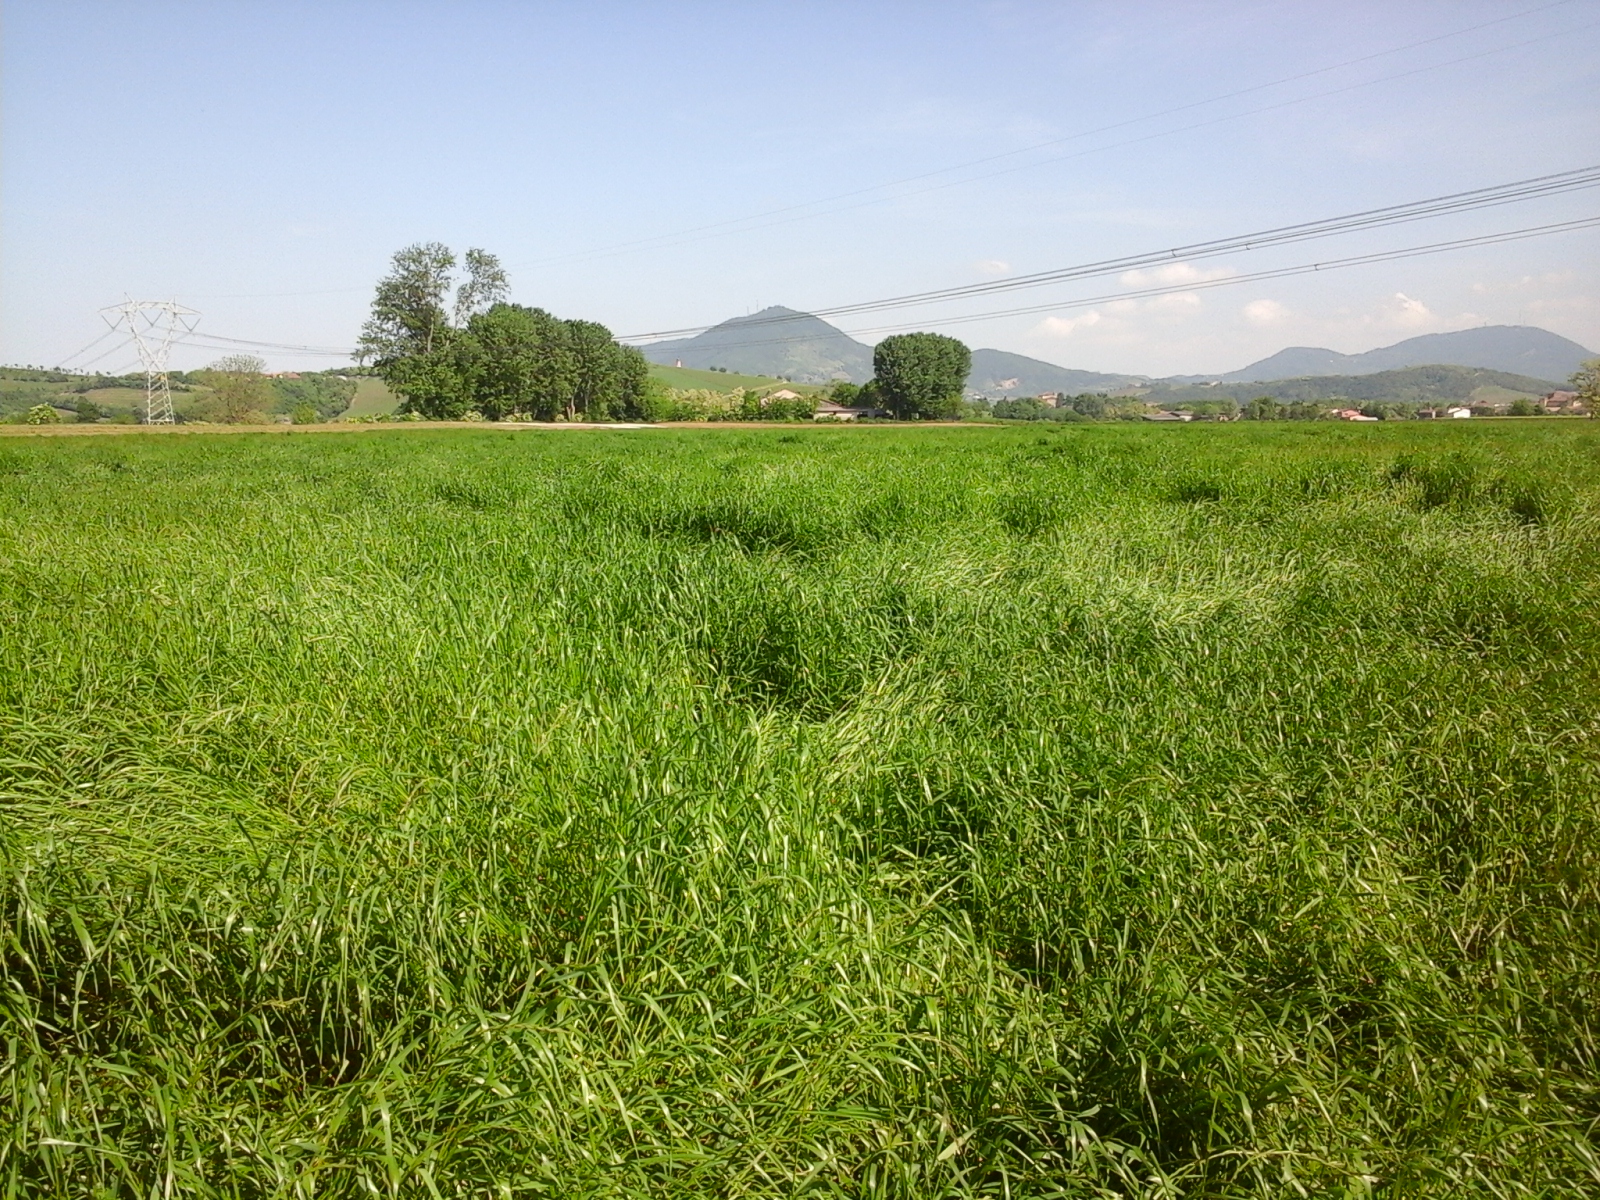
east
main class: Cropland
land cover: Temporary grasslands
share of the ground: > 75 %
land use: Agriculture (excluding fallow land and kitchen gardens)
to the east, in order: Temporary grasslands; Electric lines; Temporary grasslands
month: May
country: IT
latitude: 45.3666
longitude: 11.5677
